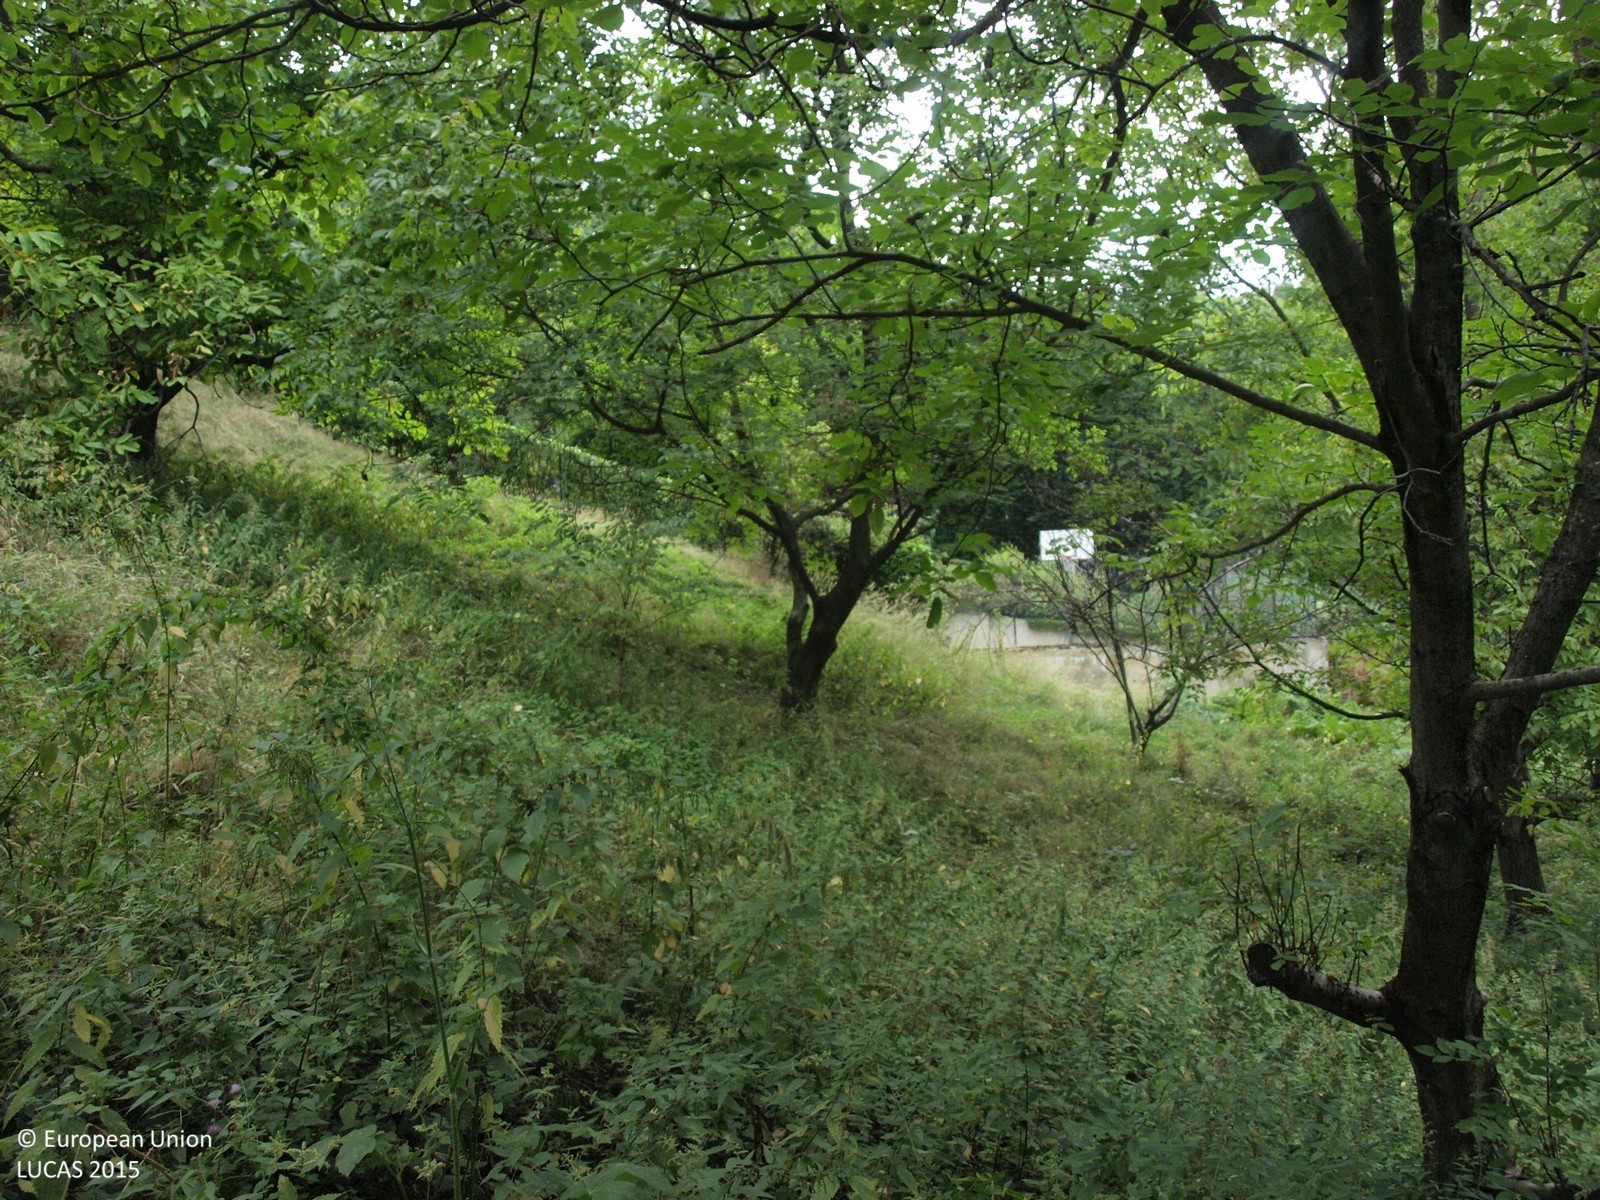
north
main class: Cropland
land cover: Nuts trees
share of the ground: 50 - 75 %
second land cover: Grassland without tree/shrub cover
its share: > 75 %
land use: Agriculture (excluding fallow land and kitchen gardens)
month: August
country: HR
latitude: 45.8419
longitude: 15.9594
